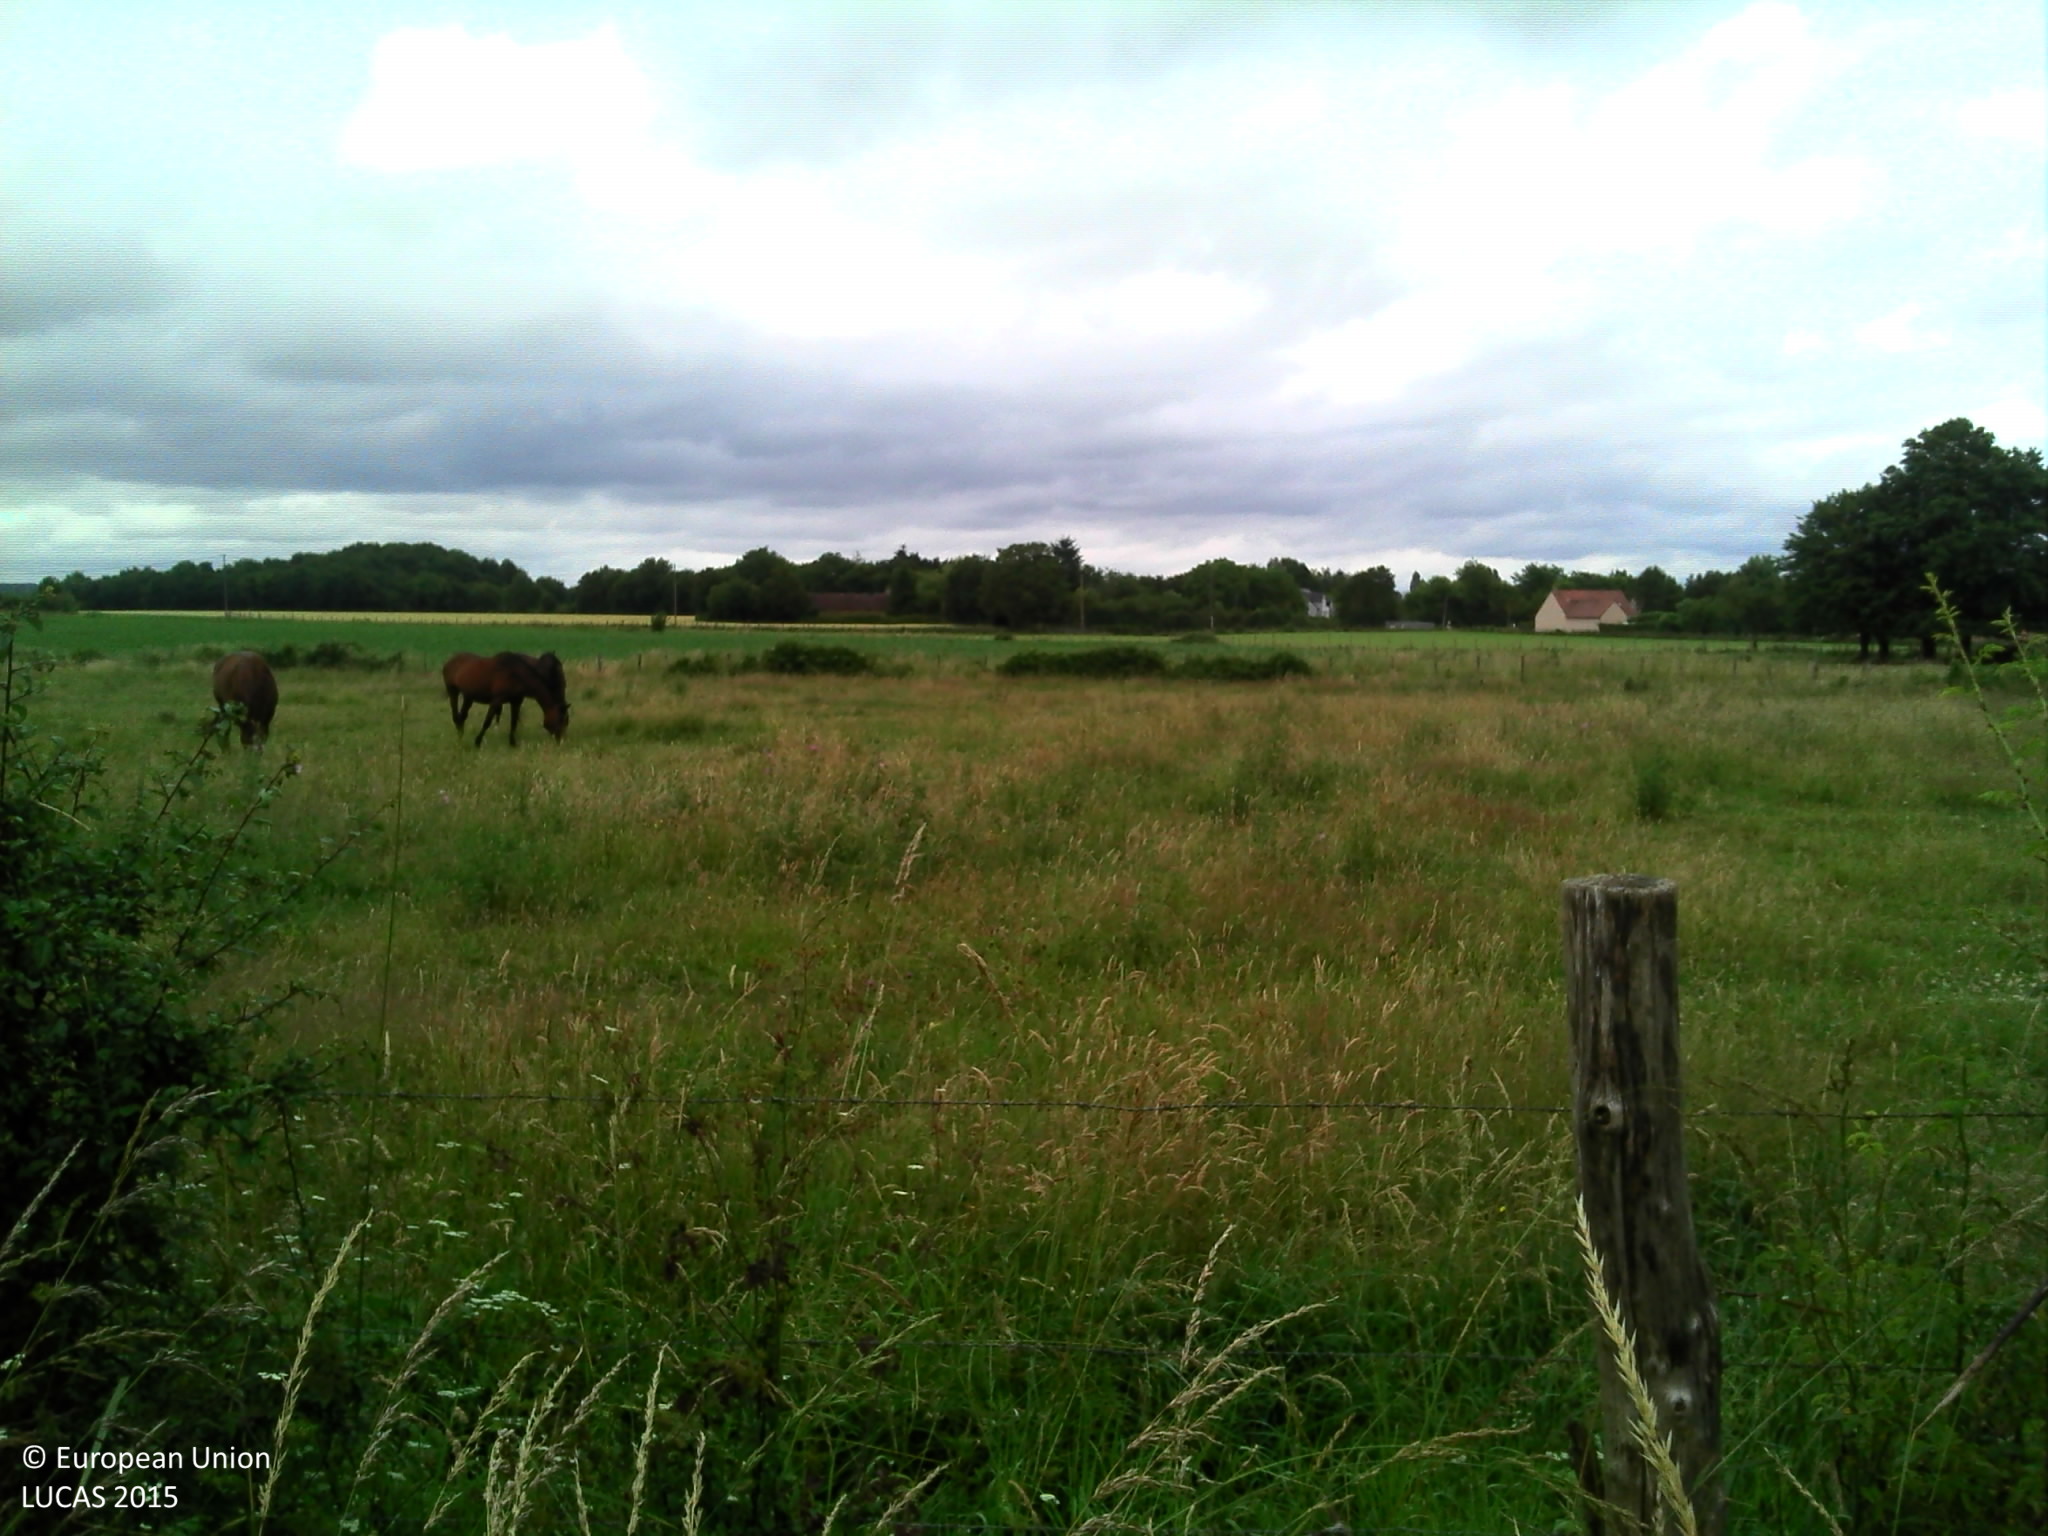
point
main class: Grassland
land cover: Grassland without tree/shrub cover
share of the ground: > 75 %
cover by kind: herbaceous plants 100 %
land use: Agriculture (excluding fallow land and kitchen gardens)
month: June
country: FR
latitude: 48.0844
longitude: 0.2955
